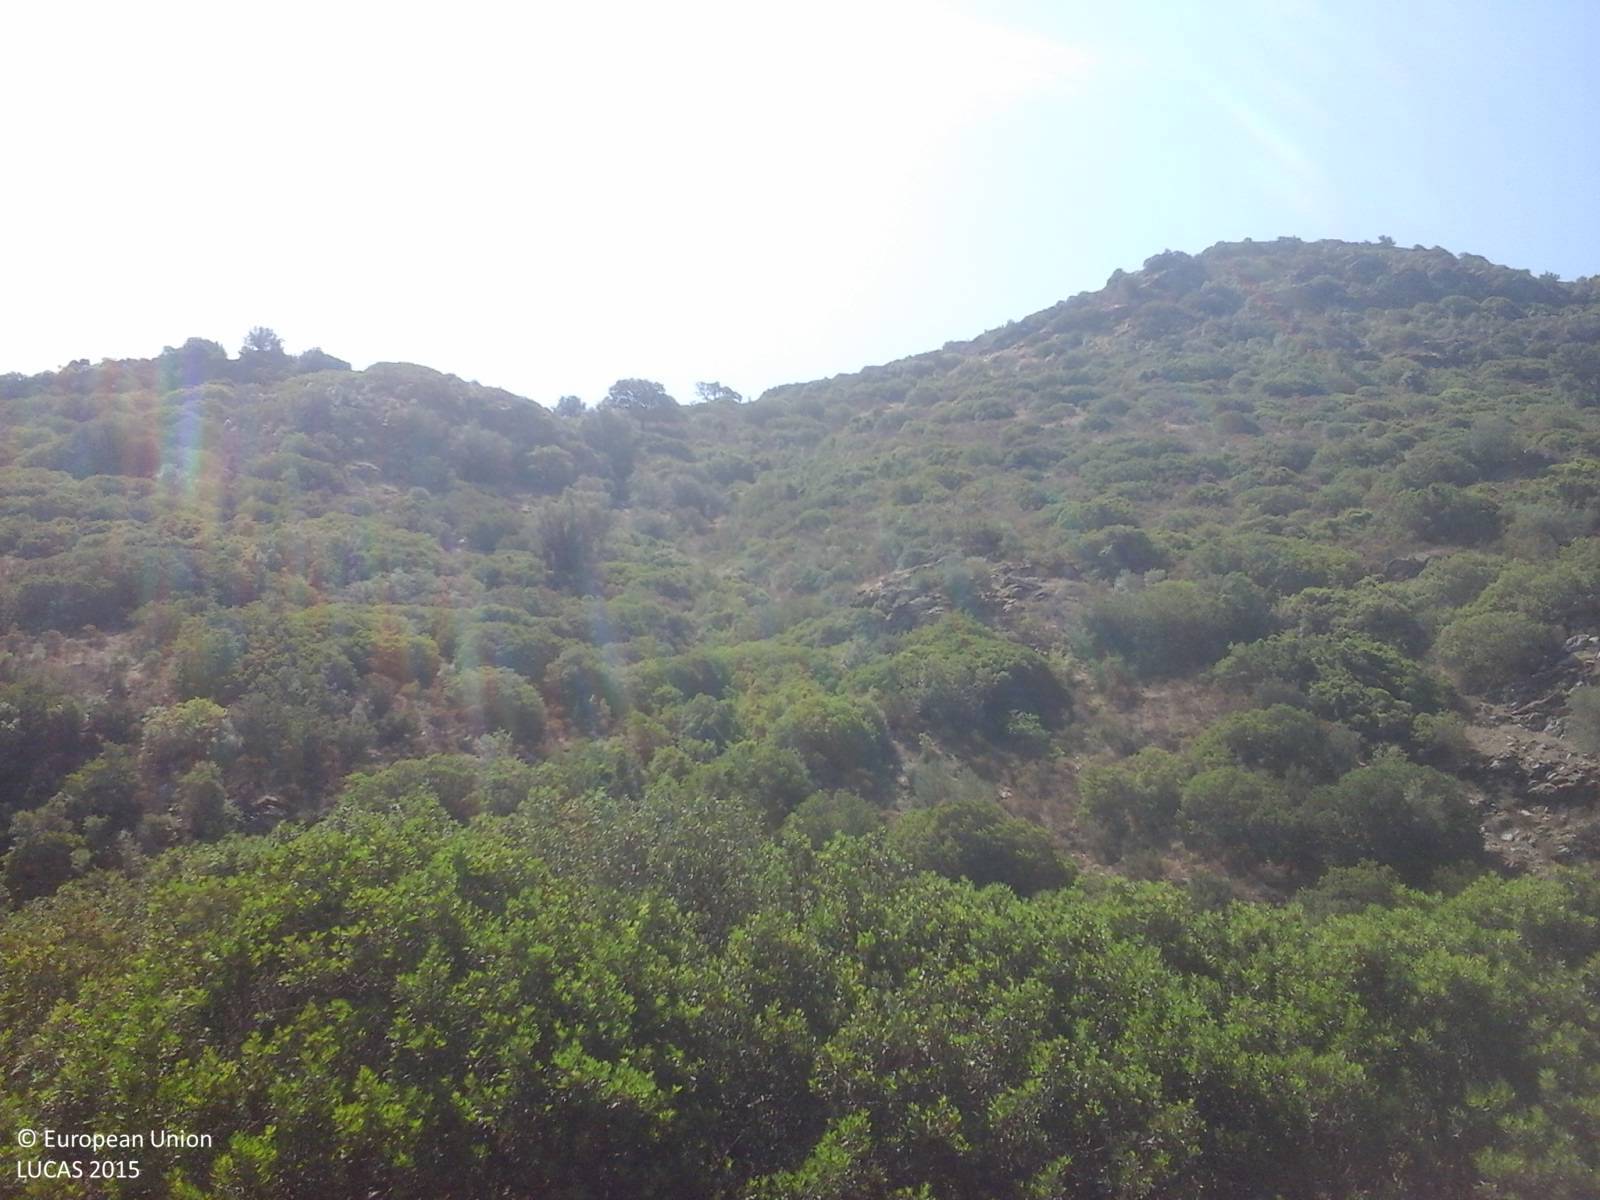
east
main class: Shrubland
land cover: Shrubland without tree cover
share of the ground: > 75 %
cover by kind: shrubs 85 %, unconsolidated bare surface 15 %
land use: Semi-natural and natural areas not in use
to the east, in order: Shrubland without tree cover; Grassland without tree/shrub cover; Fences; Grass margins; Paved roads, cycling and walking lanes; Grass margins; Shrubland without tree cover; Inland fresh running water; Broadleaved woodland; Shrubland without tree cover
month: July
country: IT
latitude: 39.5232
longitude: 9.4334
